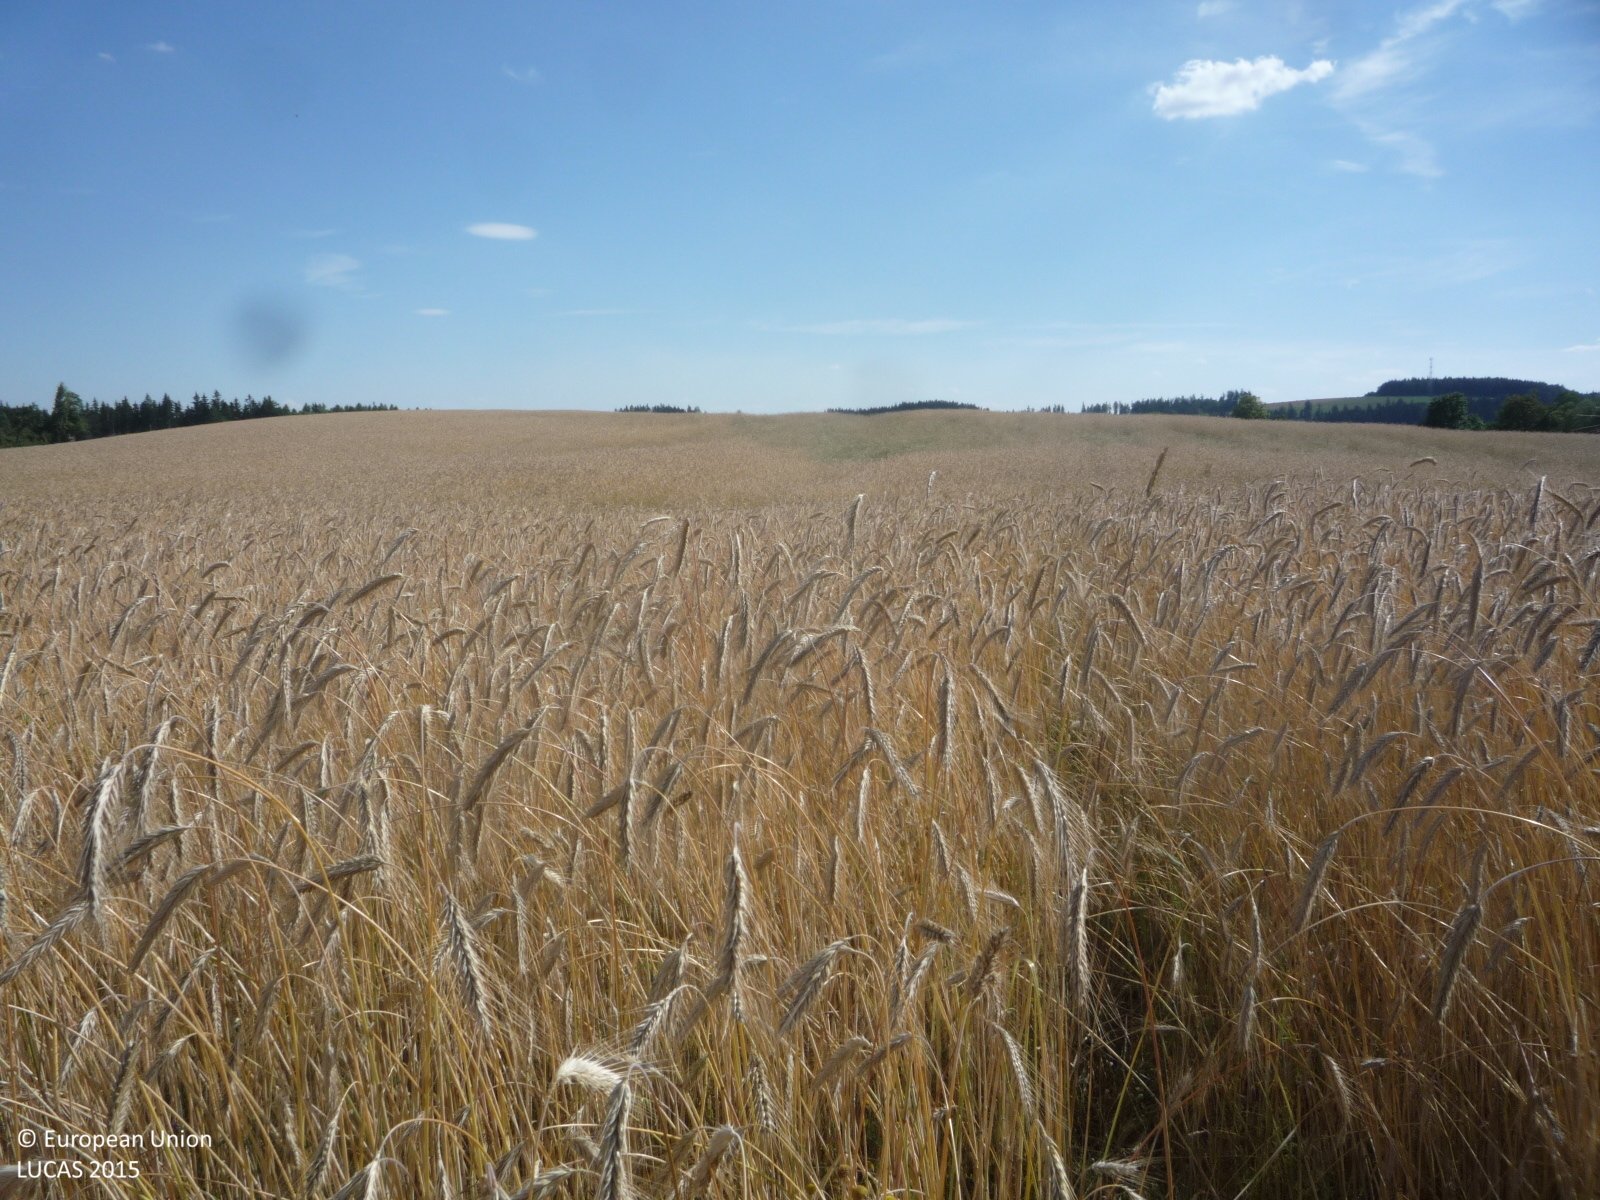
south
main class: Cropland
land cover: Rye
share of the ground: > 75 %
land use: Agriculture (excluding fallow land and kitchen gardens)
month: July
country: CZ
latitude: 50.6006
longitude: 15.6985
